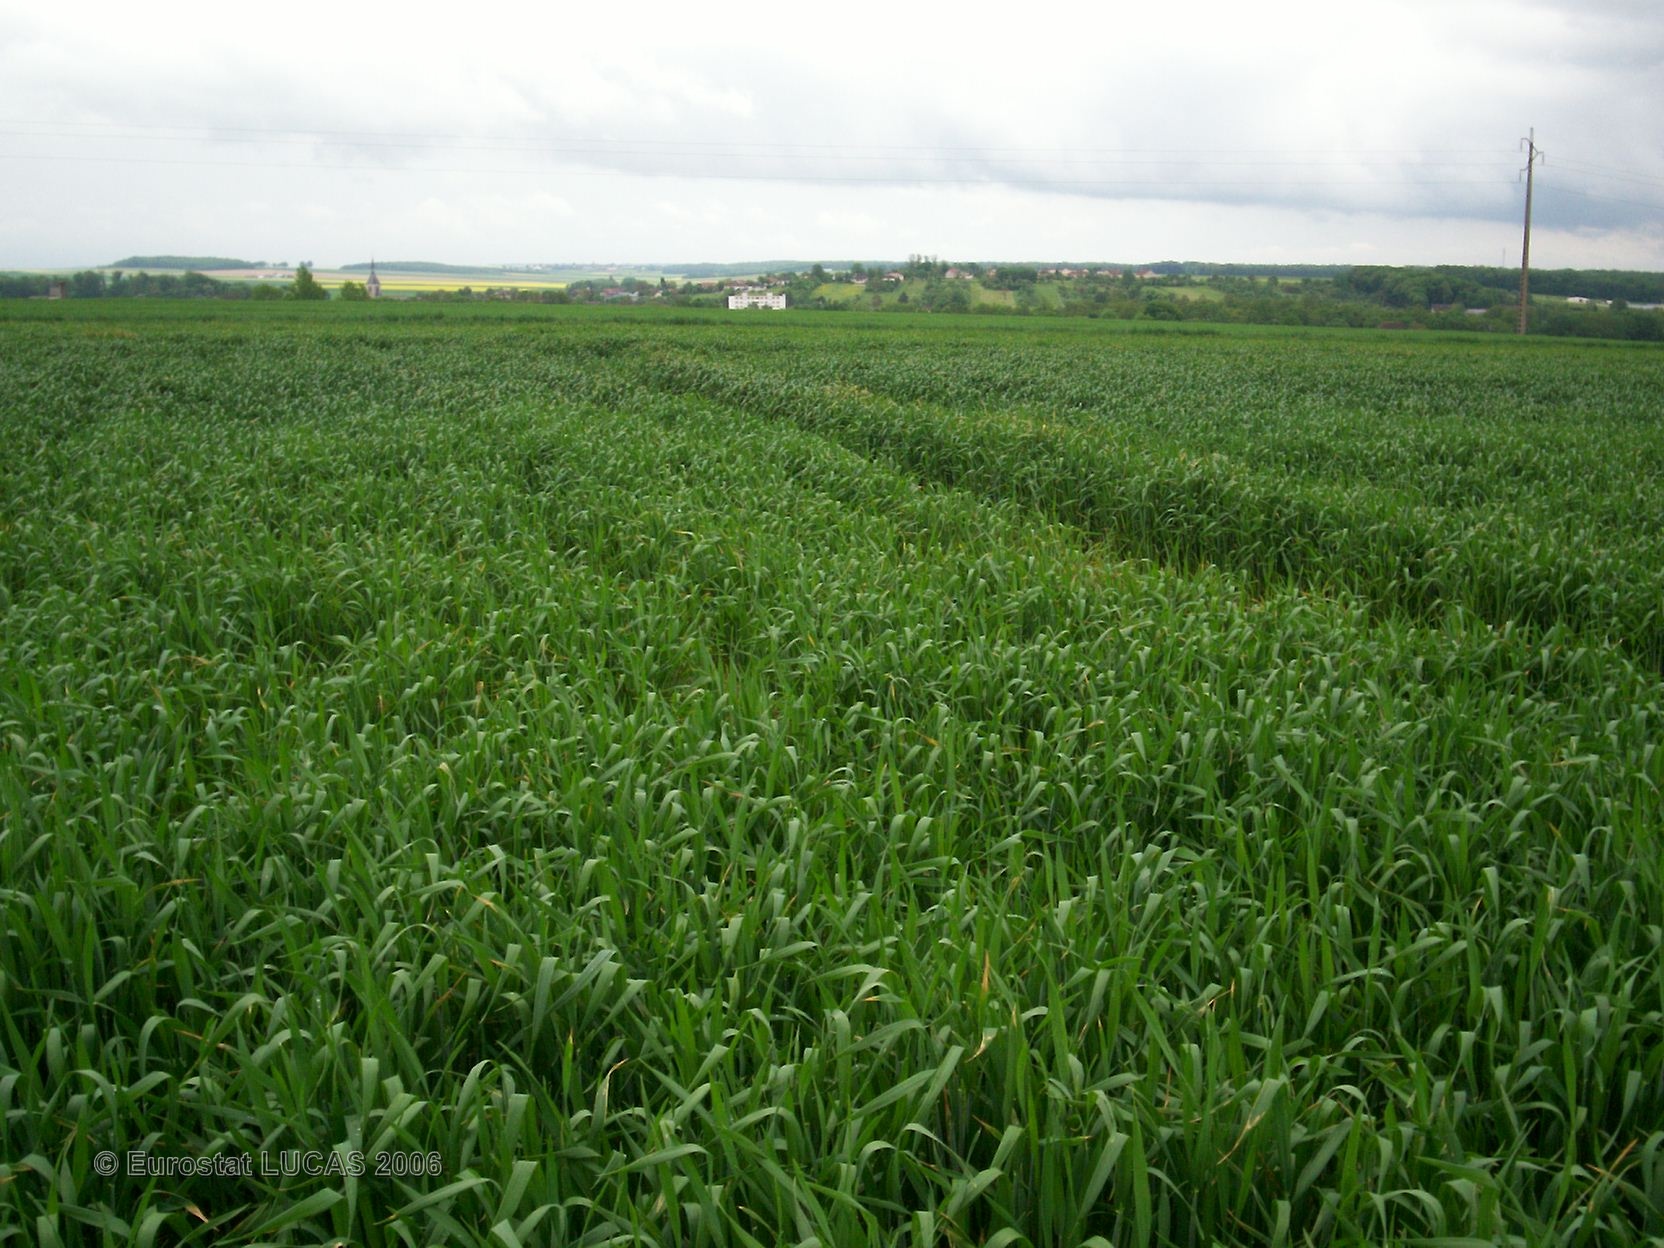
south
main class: Cropland
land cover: Common wheat
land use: Agriculture (excluding fallow land and kitchen gardens)
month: May
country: FR
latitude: 48.2467
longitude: 4.4627
